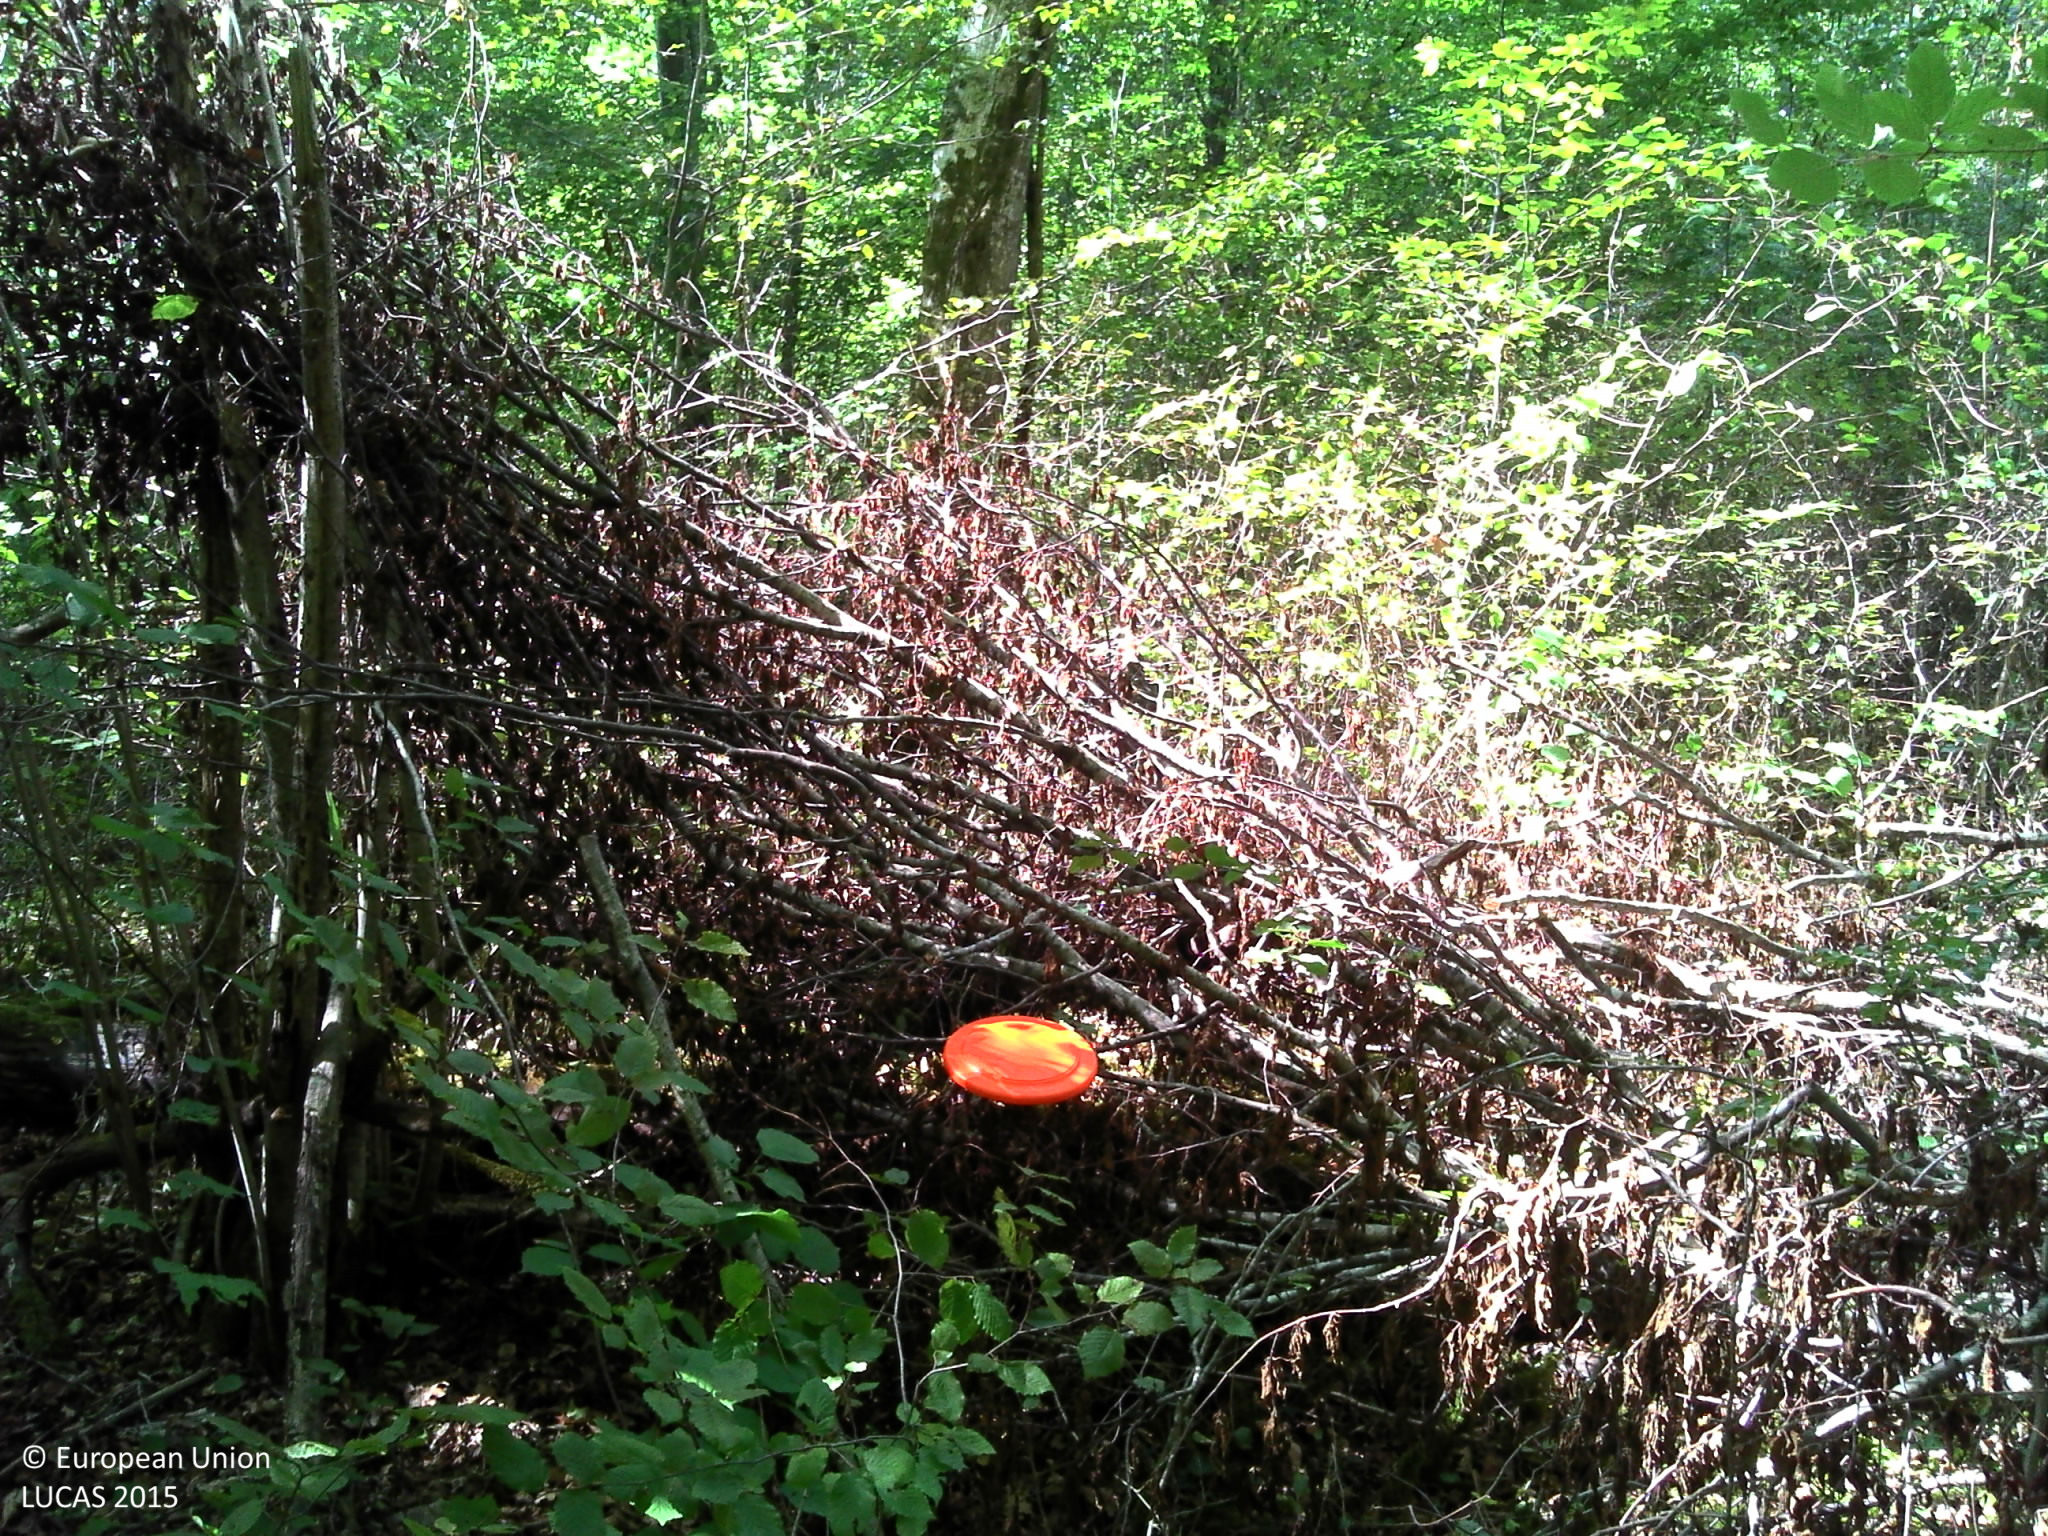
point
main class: Woodland
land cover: Broadleaved woodland
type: mesophytic deciduous forest
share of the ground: > 75 %
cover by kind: broadleaved forest trees 90 %, herbaceous plants 5 %, lichens and mosses 5 %
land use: Forestry
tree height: > 5 m
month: August
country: FR
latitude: 47.8228
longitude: 4.6426
